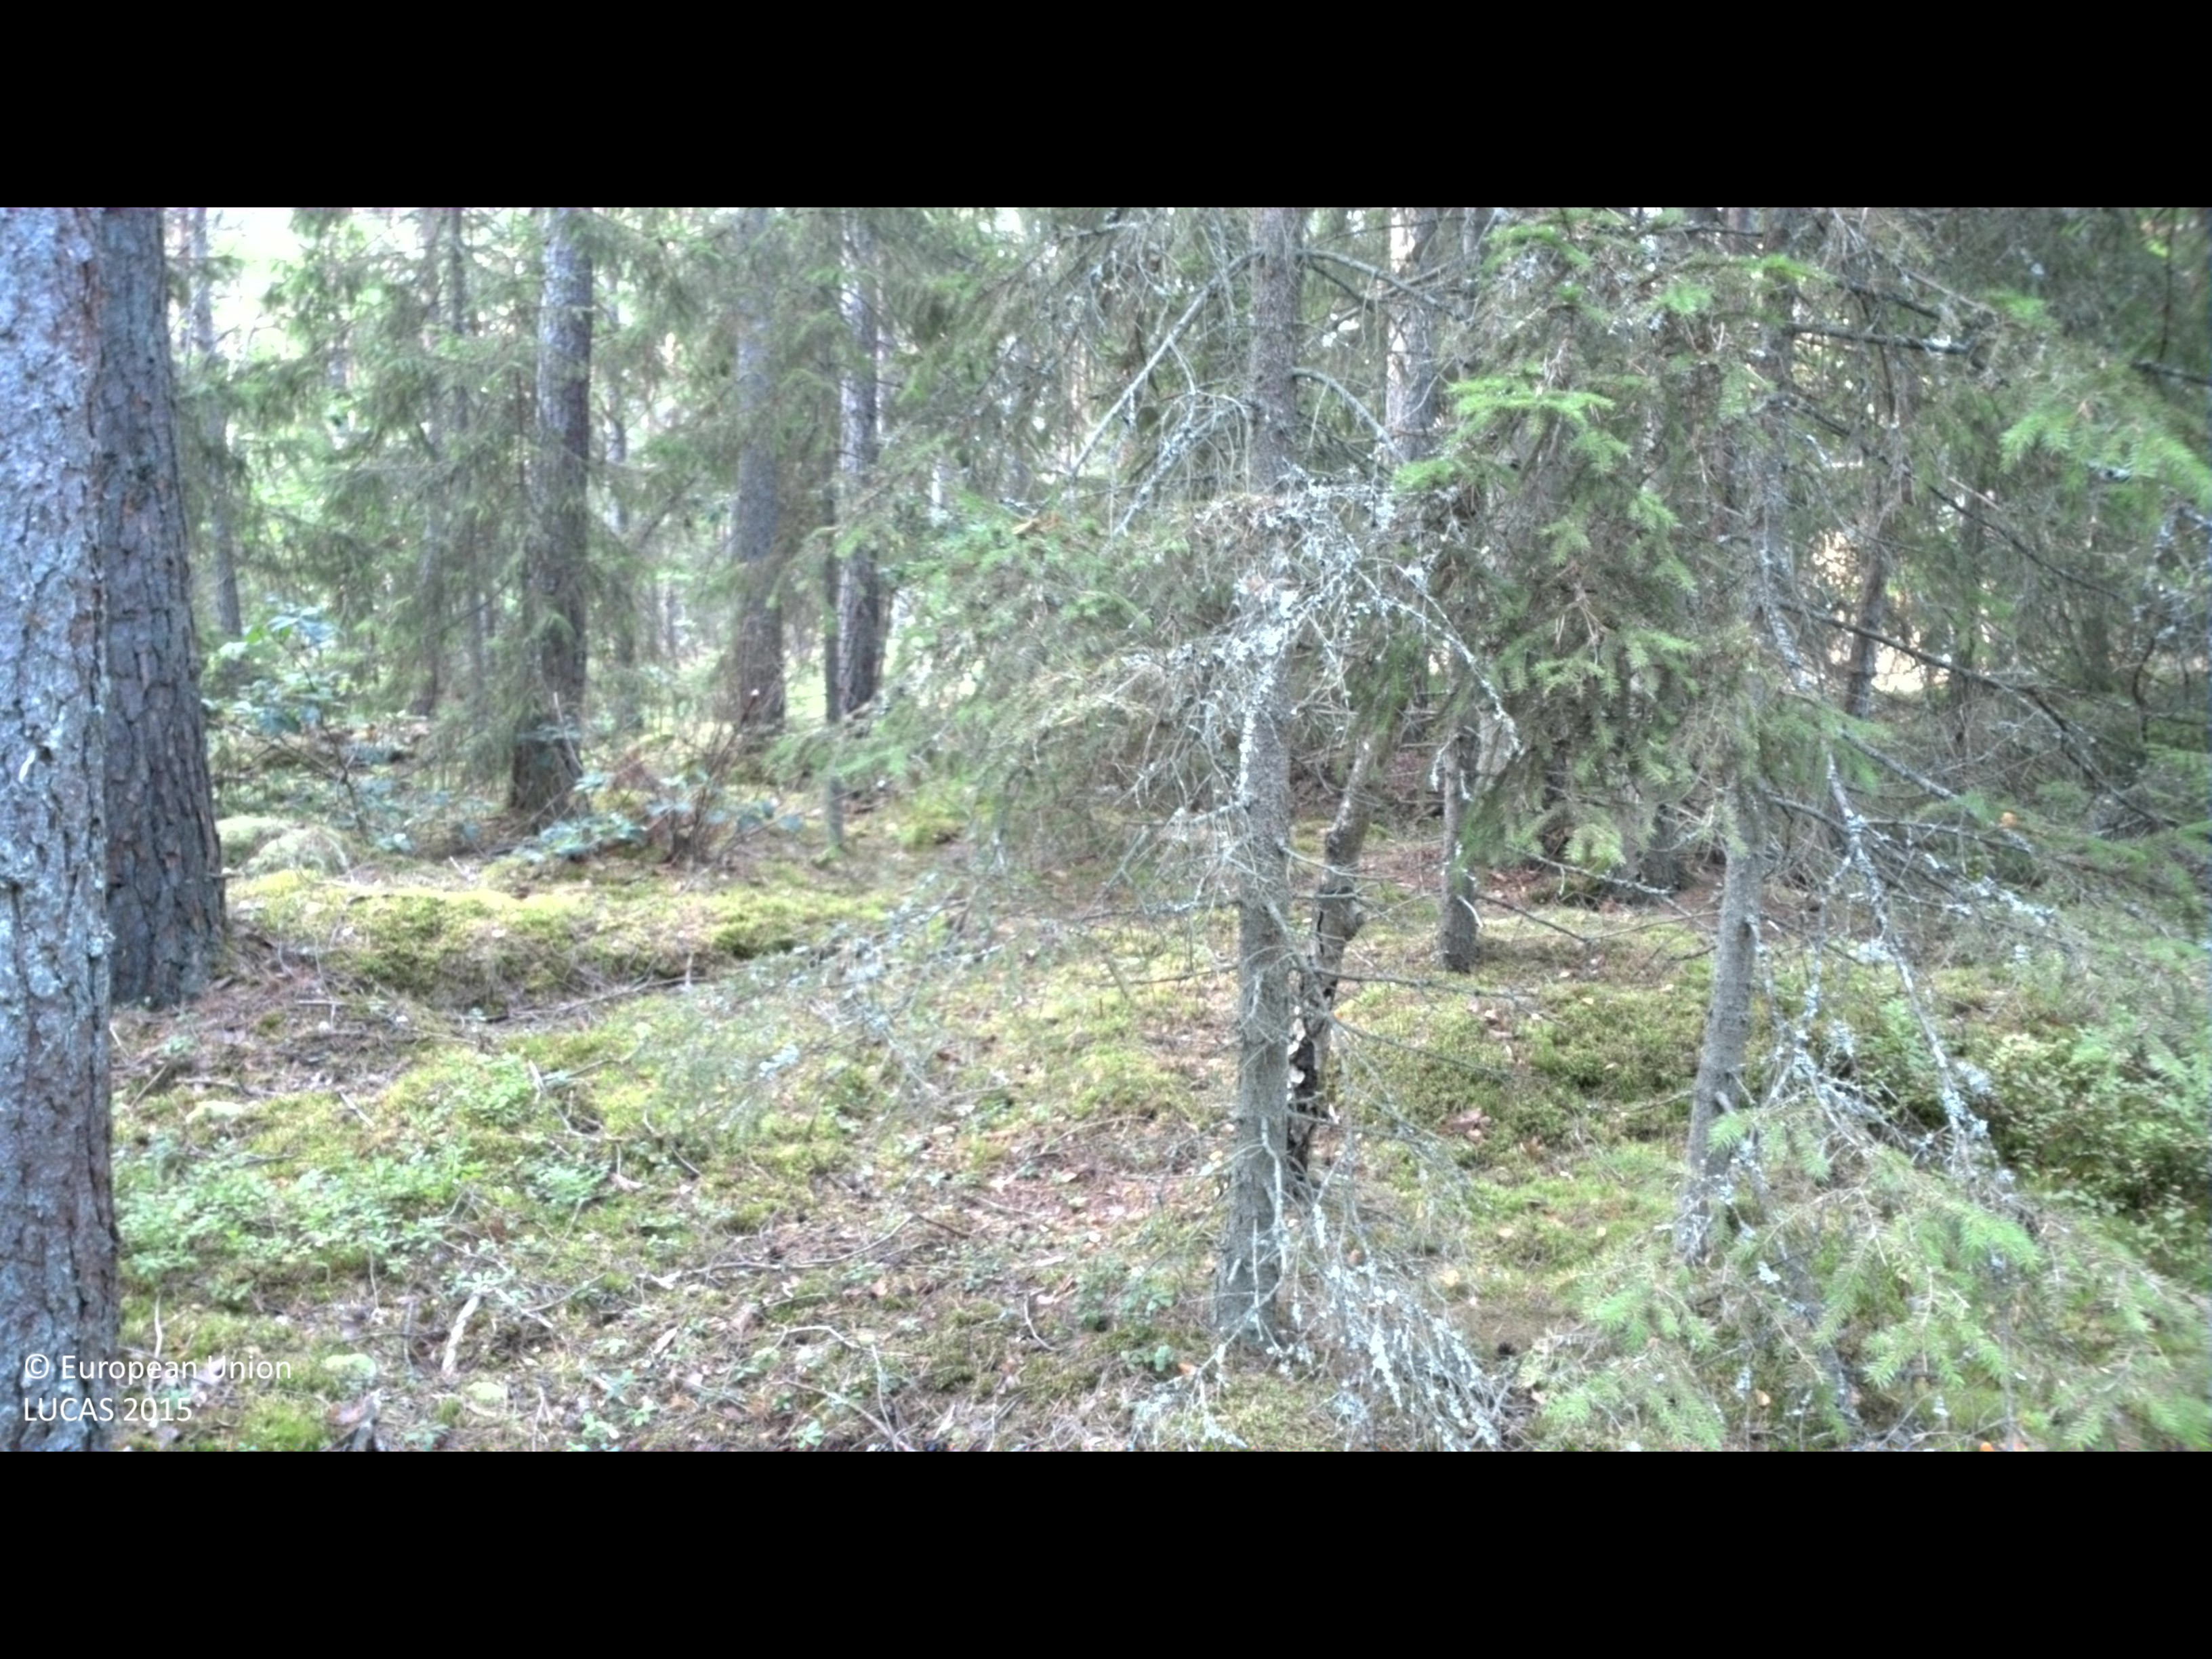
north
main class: Woodland
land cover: Spruce dominated coniferous woodland
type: boreal forest
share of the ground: 25 - 50 %
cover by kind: lichens and mosses 50 %, coniferous forest trees 35 %, shrubs 15 %
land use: Forestry
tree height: > 5 m
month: August
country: SE
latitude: 56.1725
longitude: 15.2015
